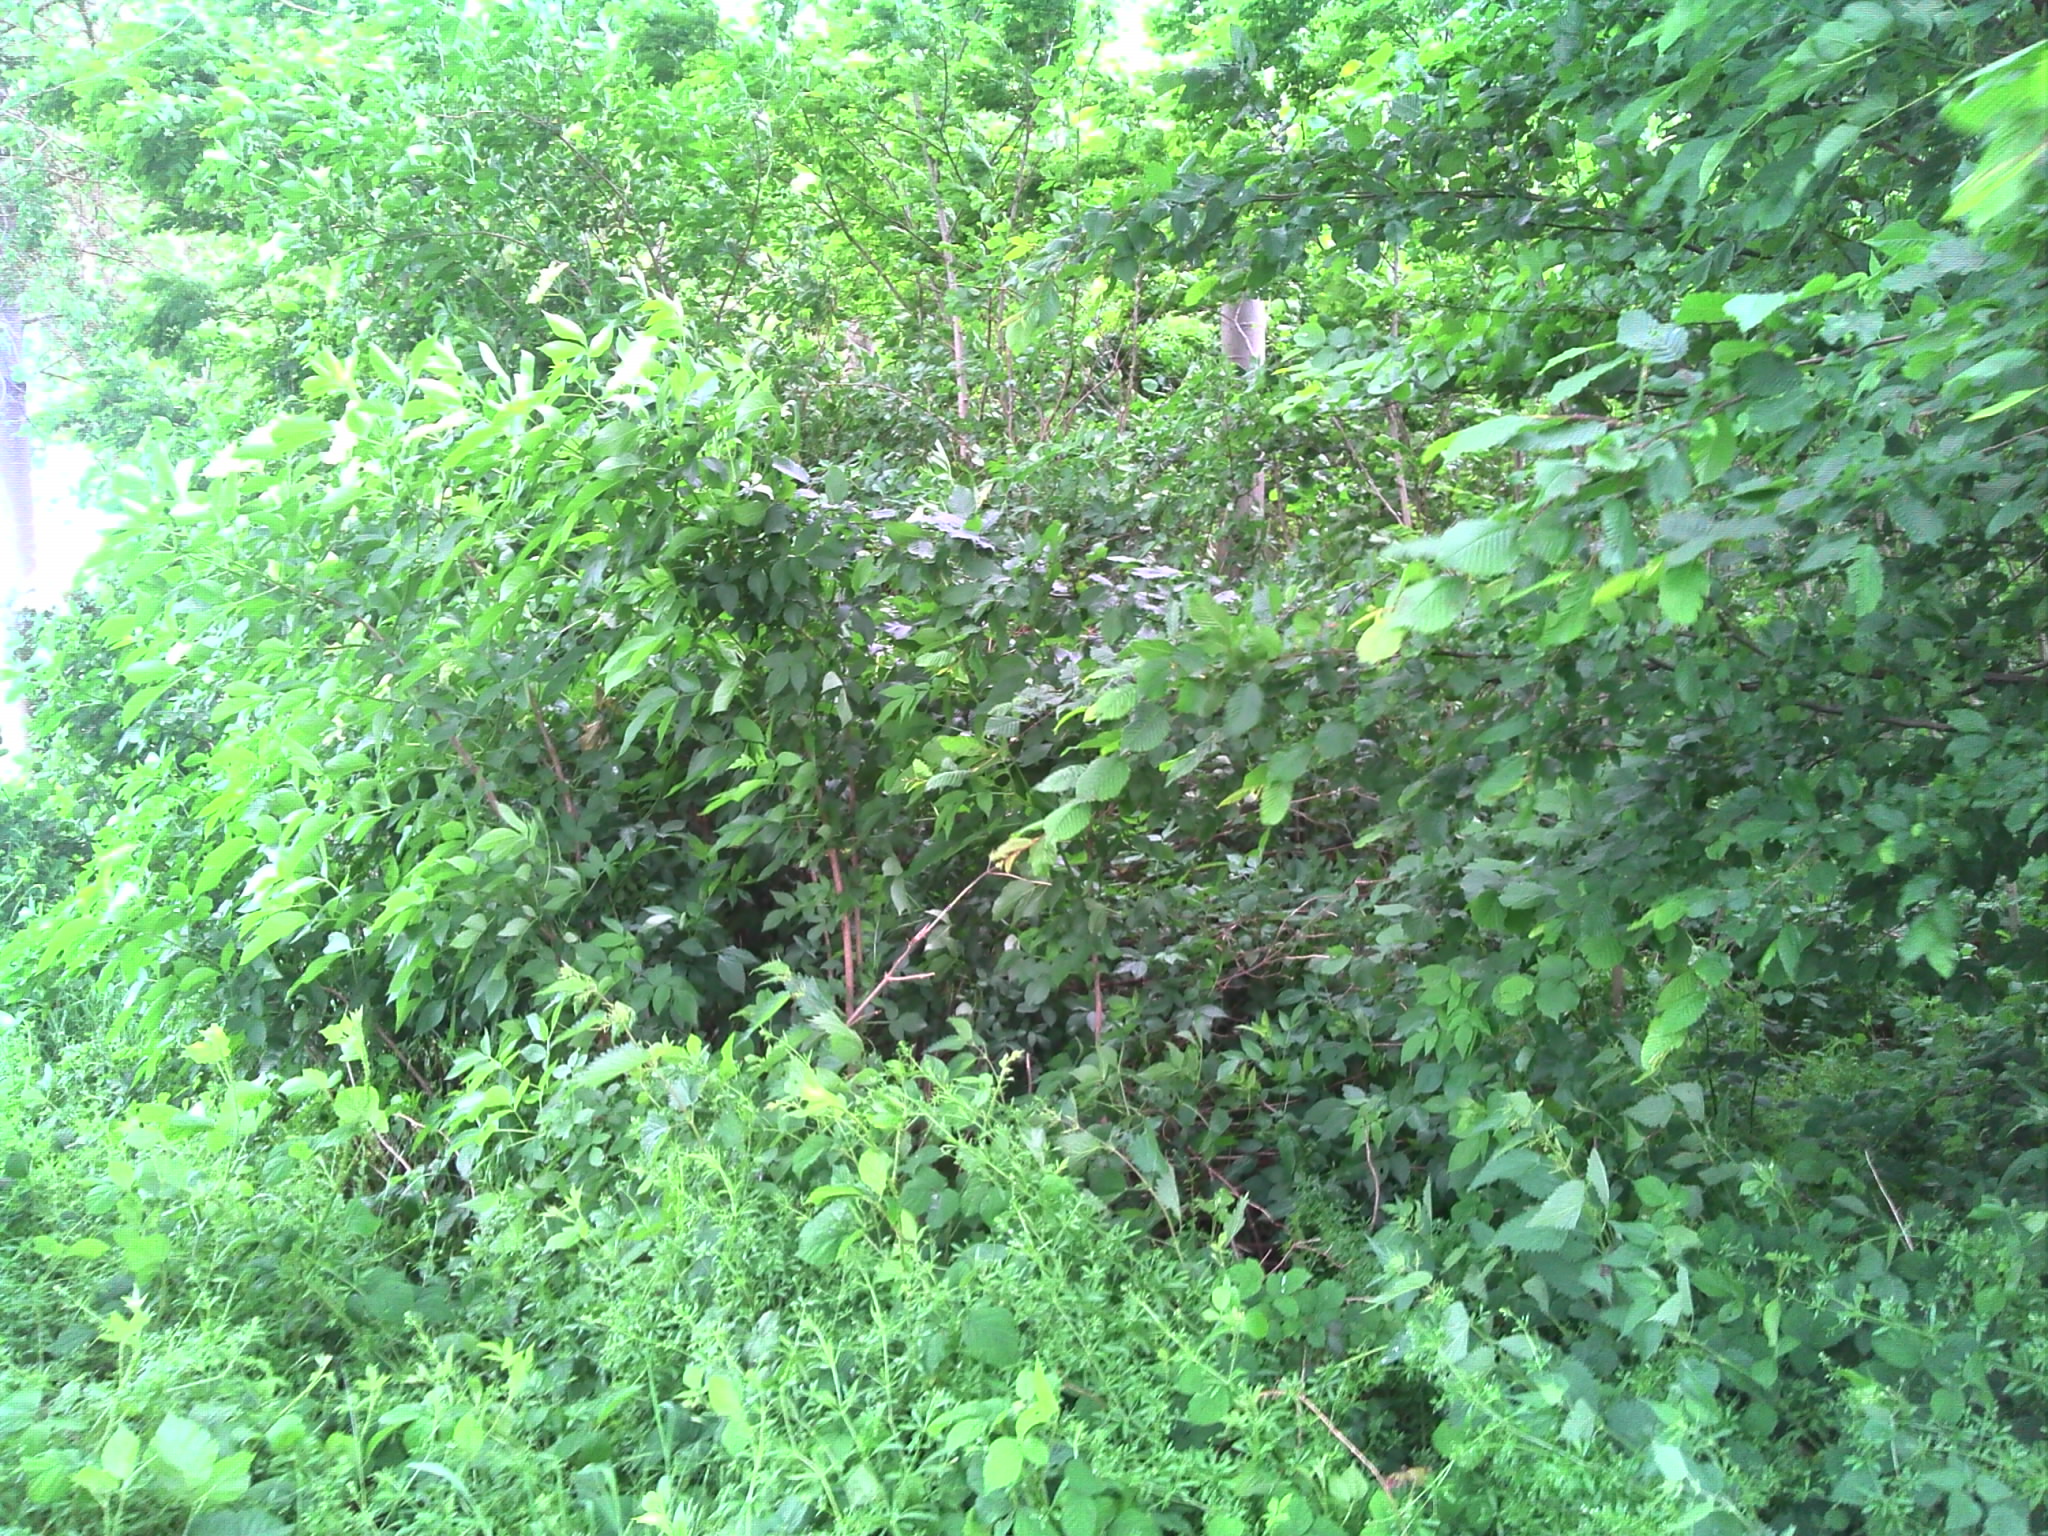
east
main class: Woodland
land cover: Broadleaved woodland
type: exotic forest
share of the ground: > 75 %
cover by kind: broadleaved forest trees 90 %, shrubs 10 %
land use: Forestry
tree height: > 5 m
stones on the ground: < 10 %
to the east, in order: Broadleaved woodland; Spontaneously vegetated surfaces; Common wheat
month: June
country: FR
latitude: 49.5858
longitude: 3.2276
